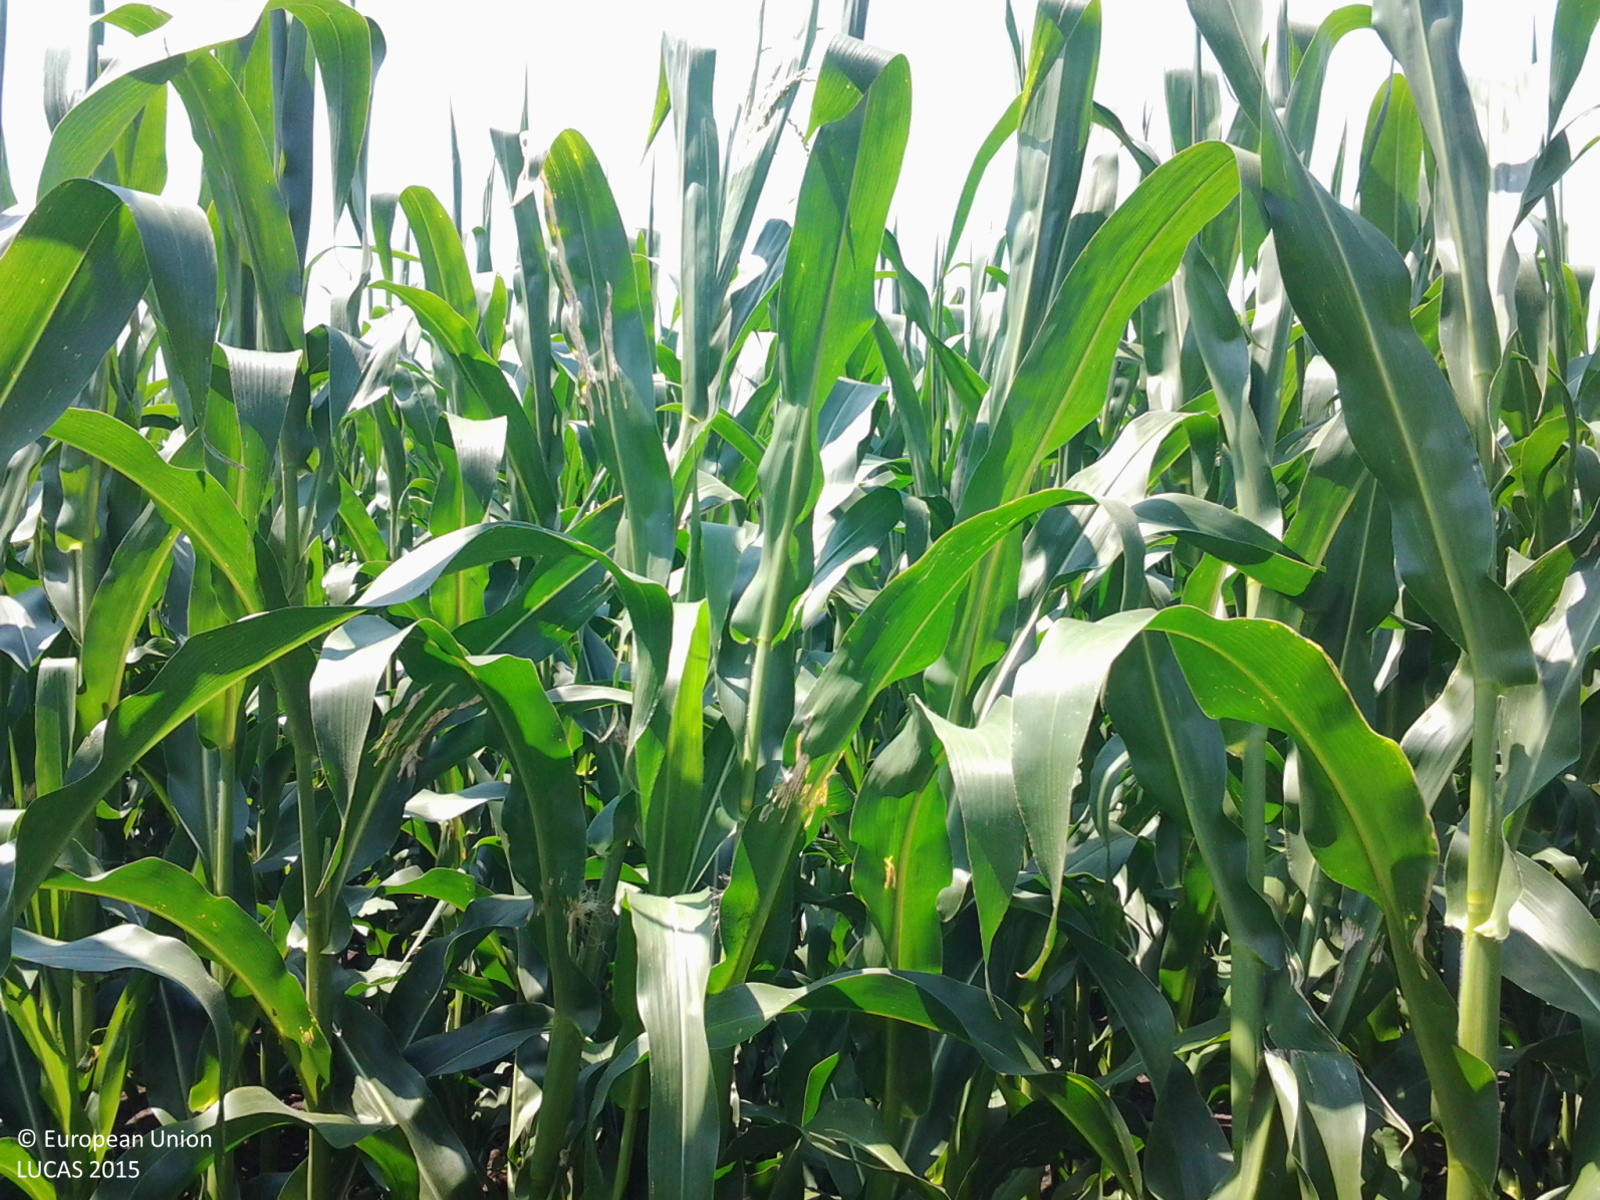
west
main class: Cropland
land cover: Maize
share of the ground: > 75 %
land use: Agriculture (excluding fallow land and kitchen gardens)
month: July
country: HU
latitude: 47.5285
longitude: 19.8403
